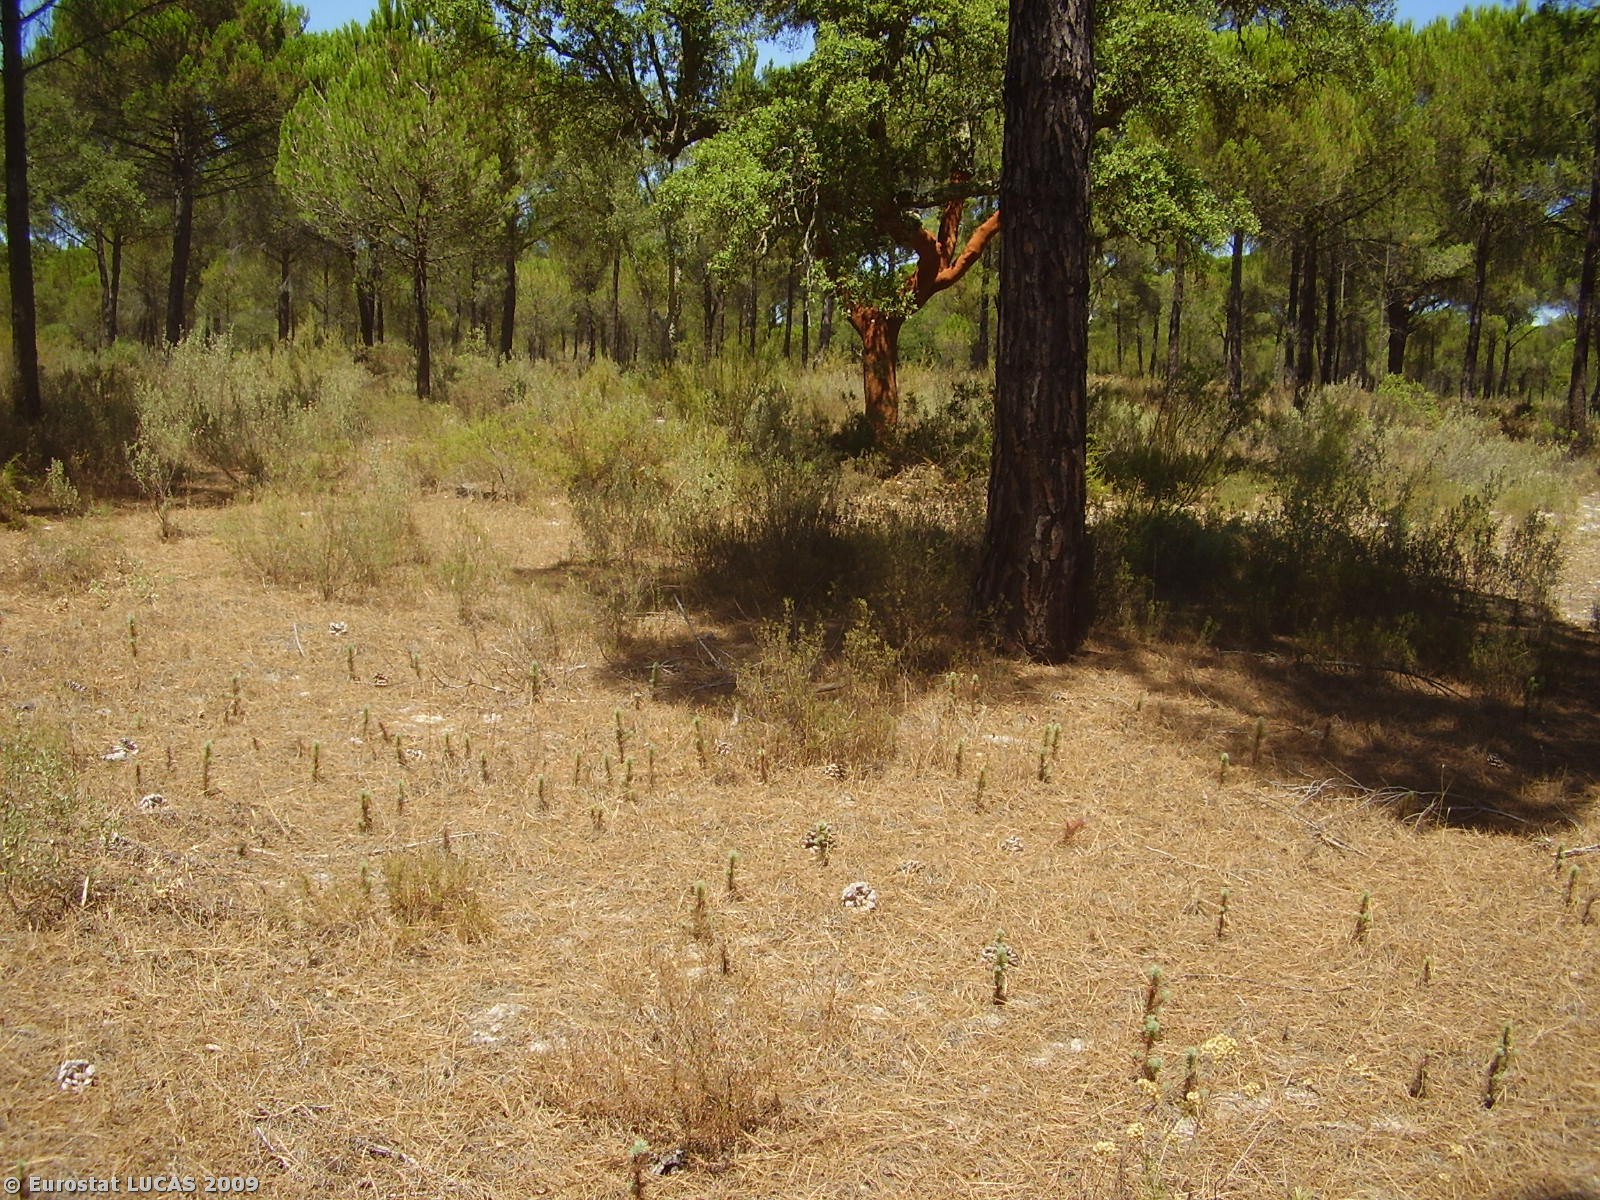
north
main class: Woodland
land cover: Coniferous woodland
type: coniferous forest of the mediterranean region
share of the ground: 10 - 25 %
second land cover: Spontaneously vegetated surfaces
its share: 25 - 50 %
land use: Forestry
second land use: Fallow land
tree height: > 5 m
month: July
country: PT
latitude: 38.1571
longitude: -8.4063
